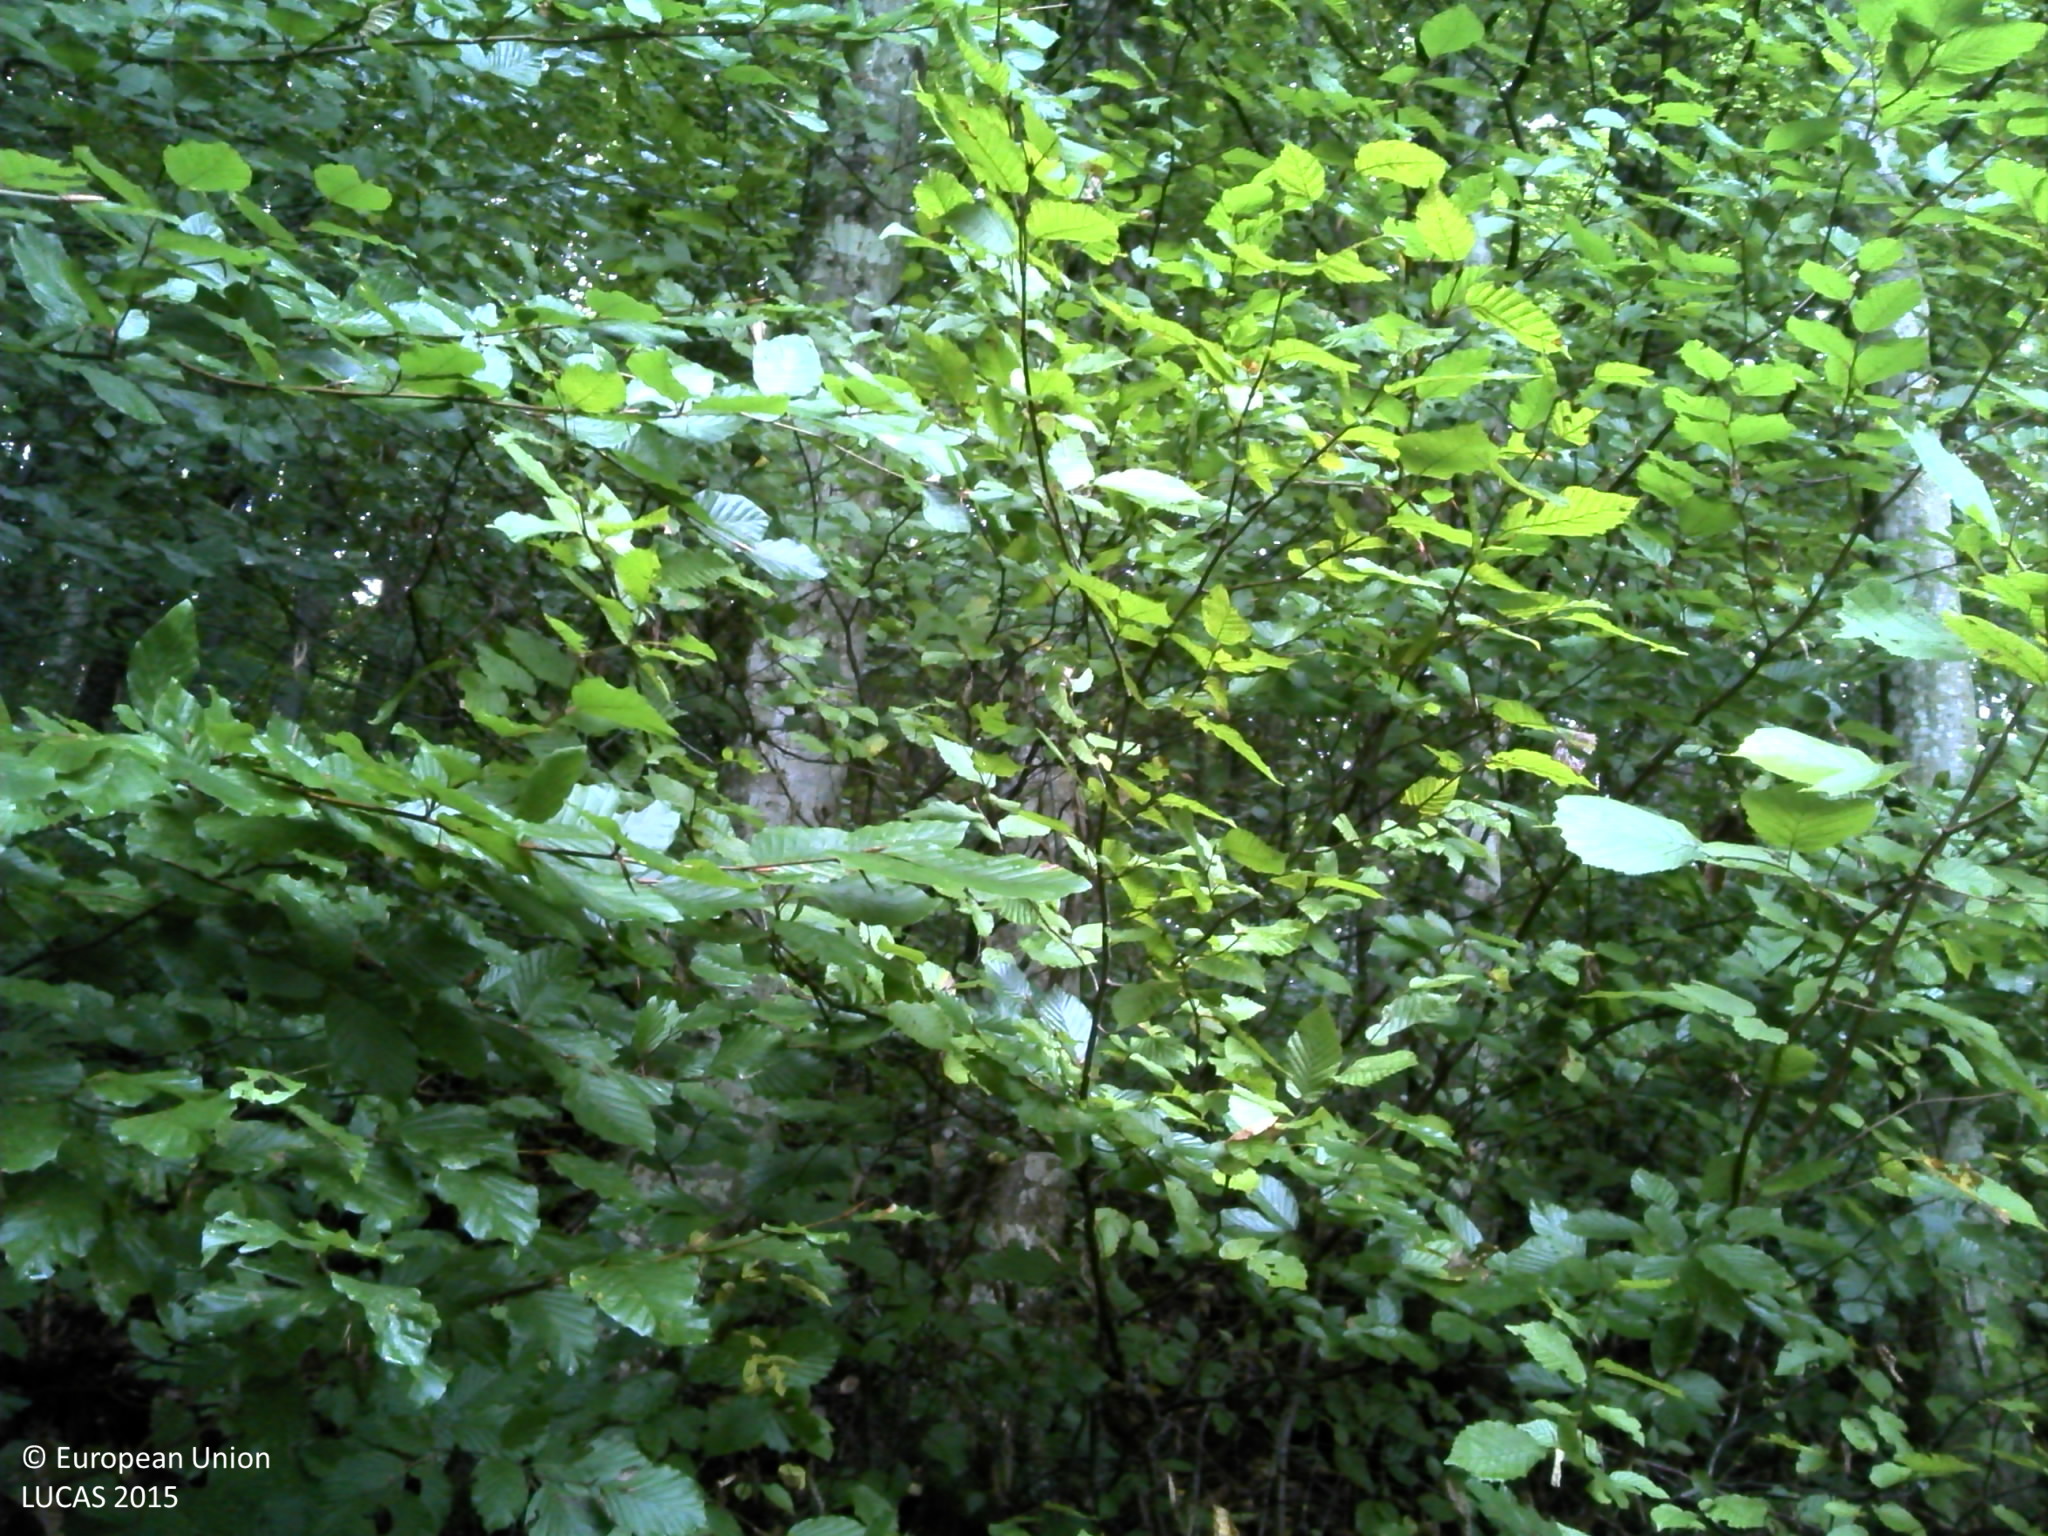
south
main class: Woodland
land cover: Broadleaved woodland
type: beech forest
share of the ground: > 75 %
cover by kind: broadleaved forest trees 100 %
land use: Forestry
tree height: > 5 m
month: August
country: HR
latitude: 45.3724
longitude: 15.6271
